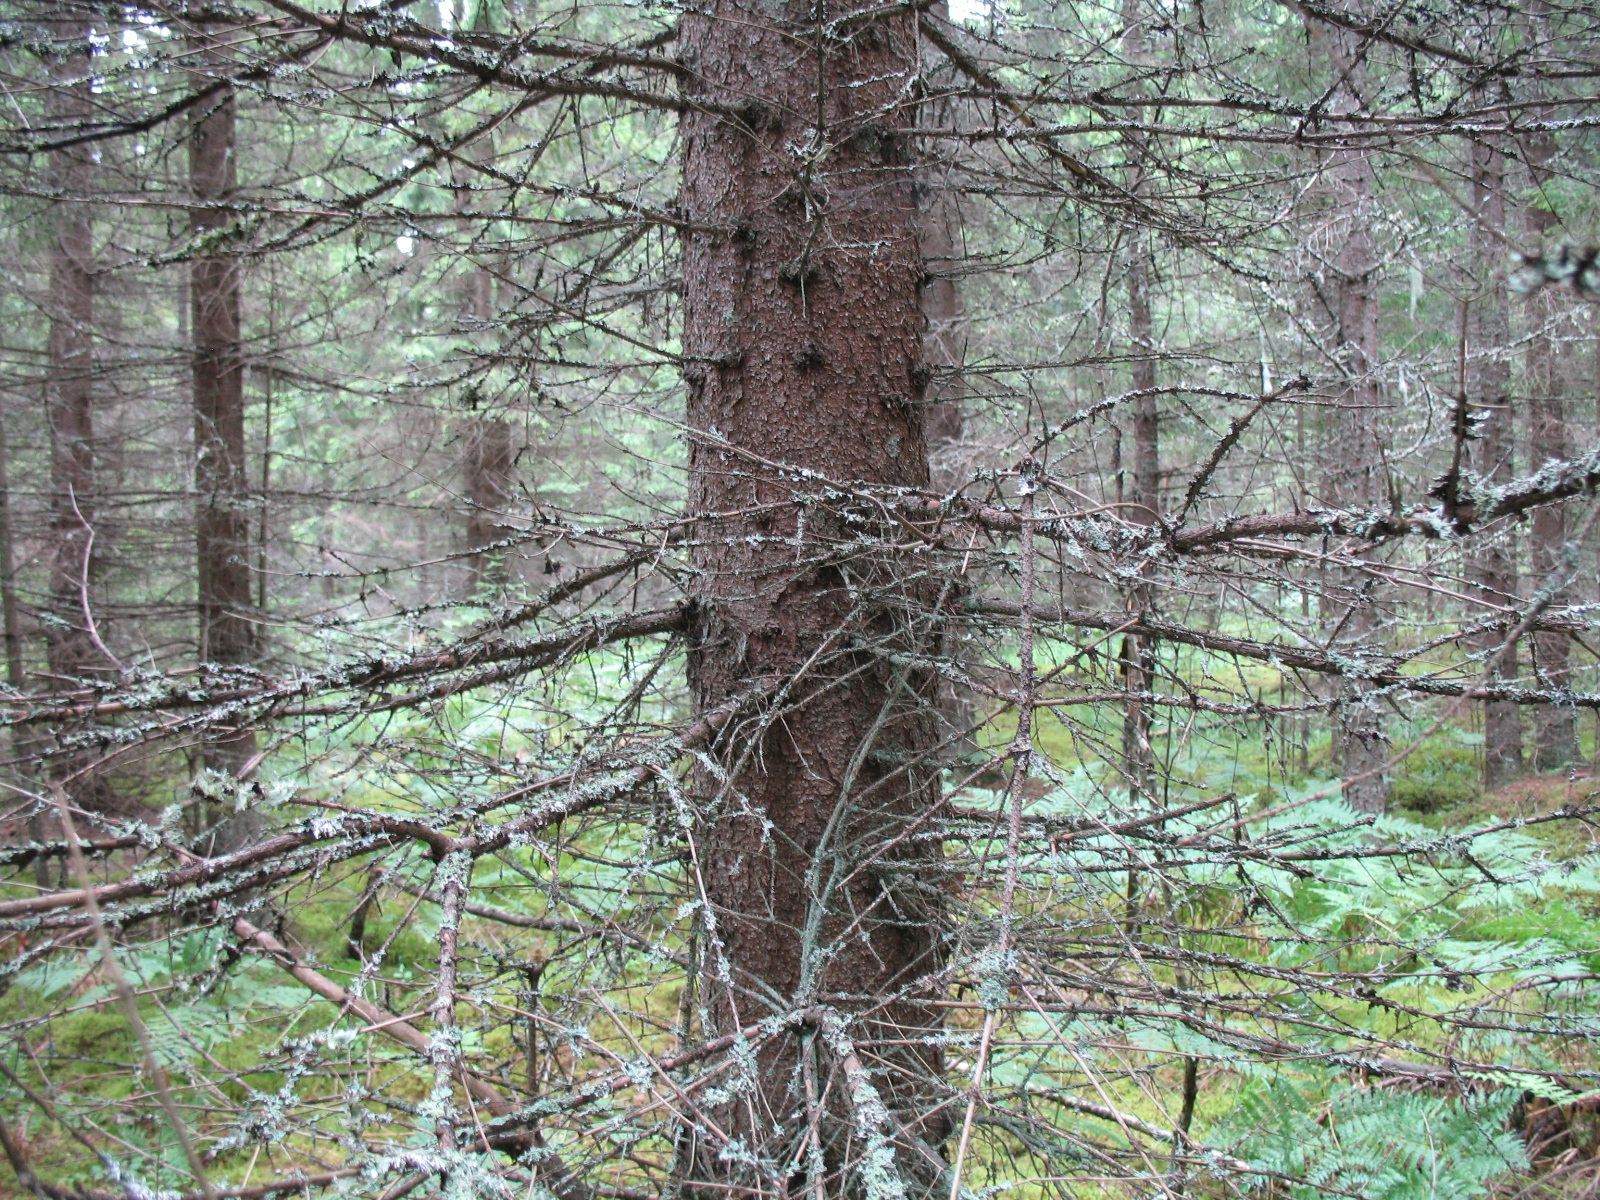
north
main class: Woodland
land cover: Spruce dominated coniferous woodland
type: hemiboreal forest and nemoral coniferous forest and mixed broadleaved-coniferous forest
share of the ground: > 75 %
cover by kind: coniferous forest trees 80 %, lichens and mosses 15 %, herbaceous plants 5 %
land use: Forestry
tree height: > 5 m
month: July
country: LV
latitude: 56.3937
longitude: 25.1951
